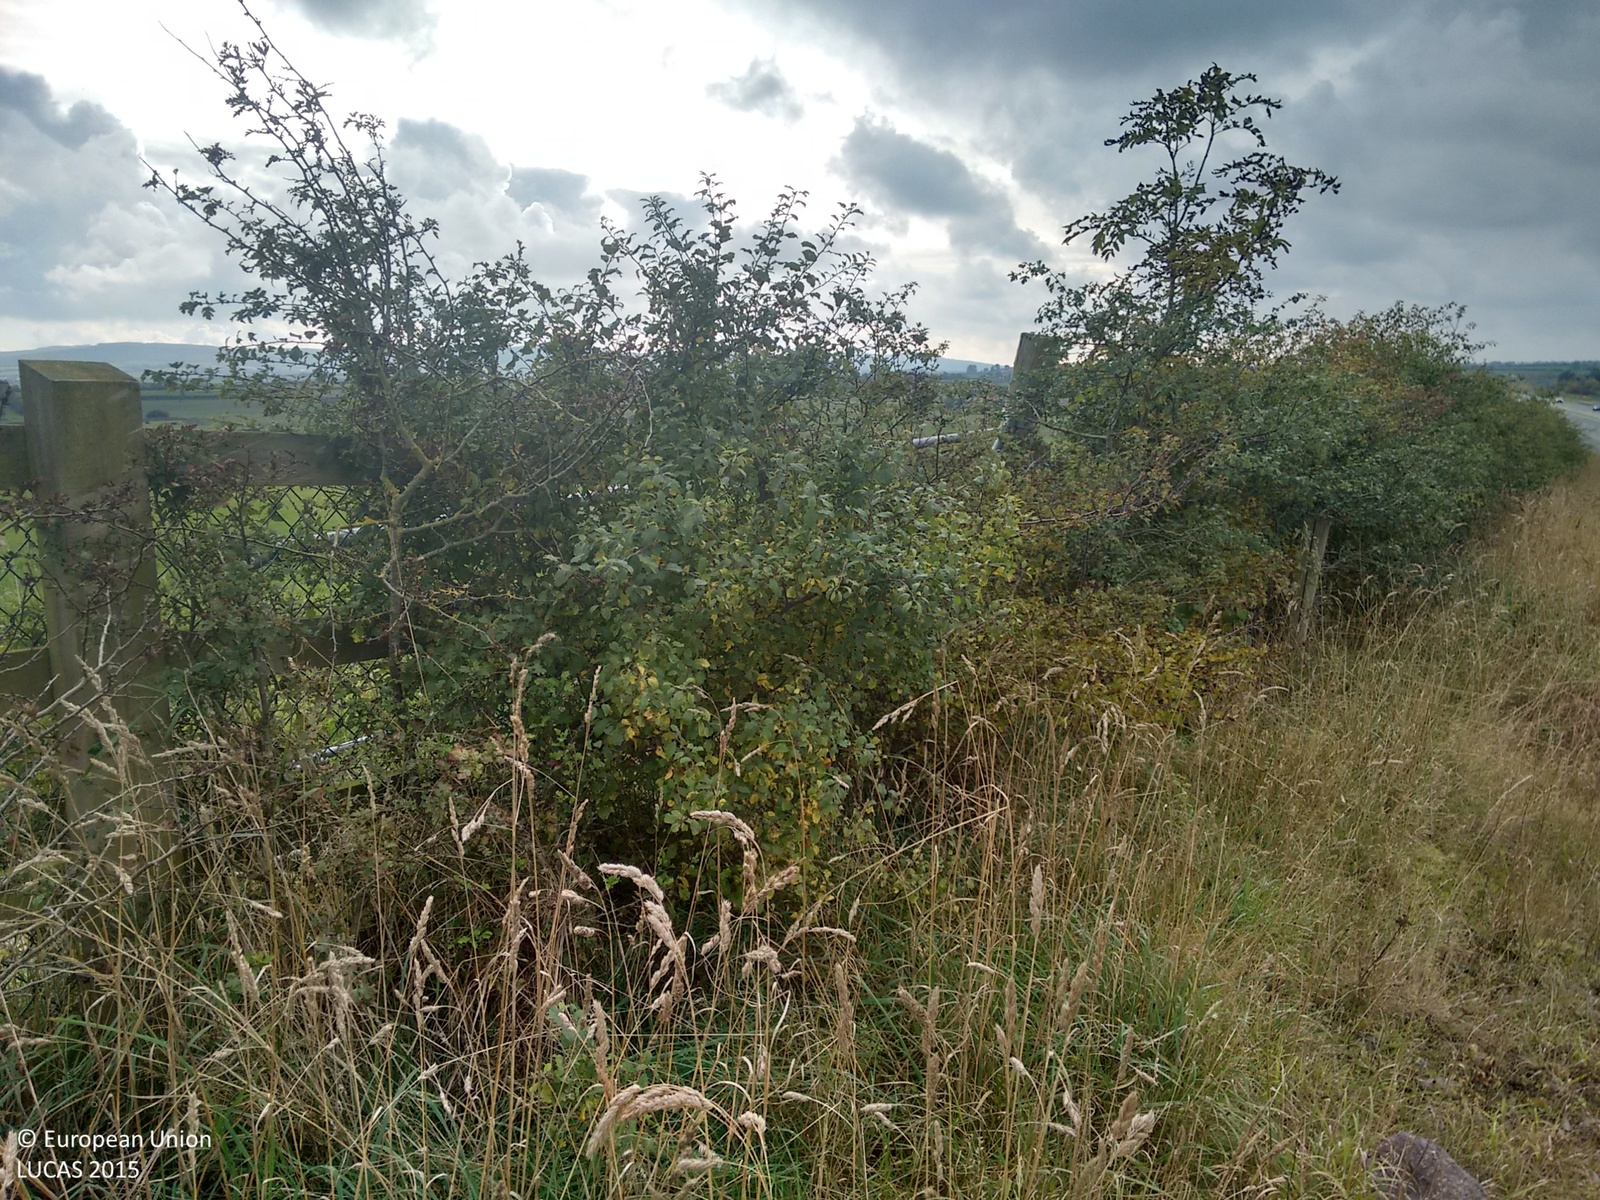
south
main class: Woodland
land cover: Broadleaved woodland
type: mesophytic deciduous forest
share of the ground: > 75 %
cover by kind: broadleaved forest trees 65 %, herbaceous plants 35 %
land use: Forestry
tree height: > 5 m
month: October
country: IE
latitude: 52.8515
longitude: -7.4879
